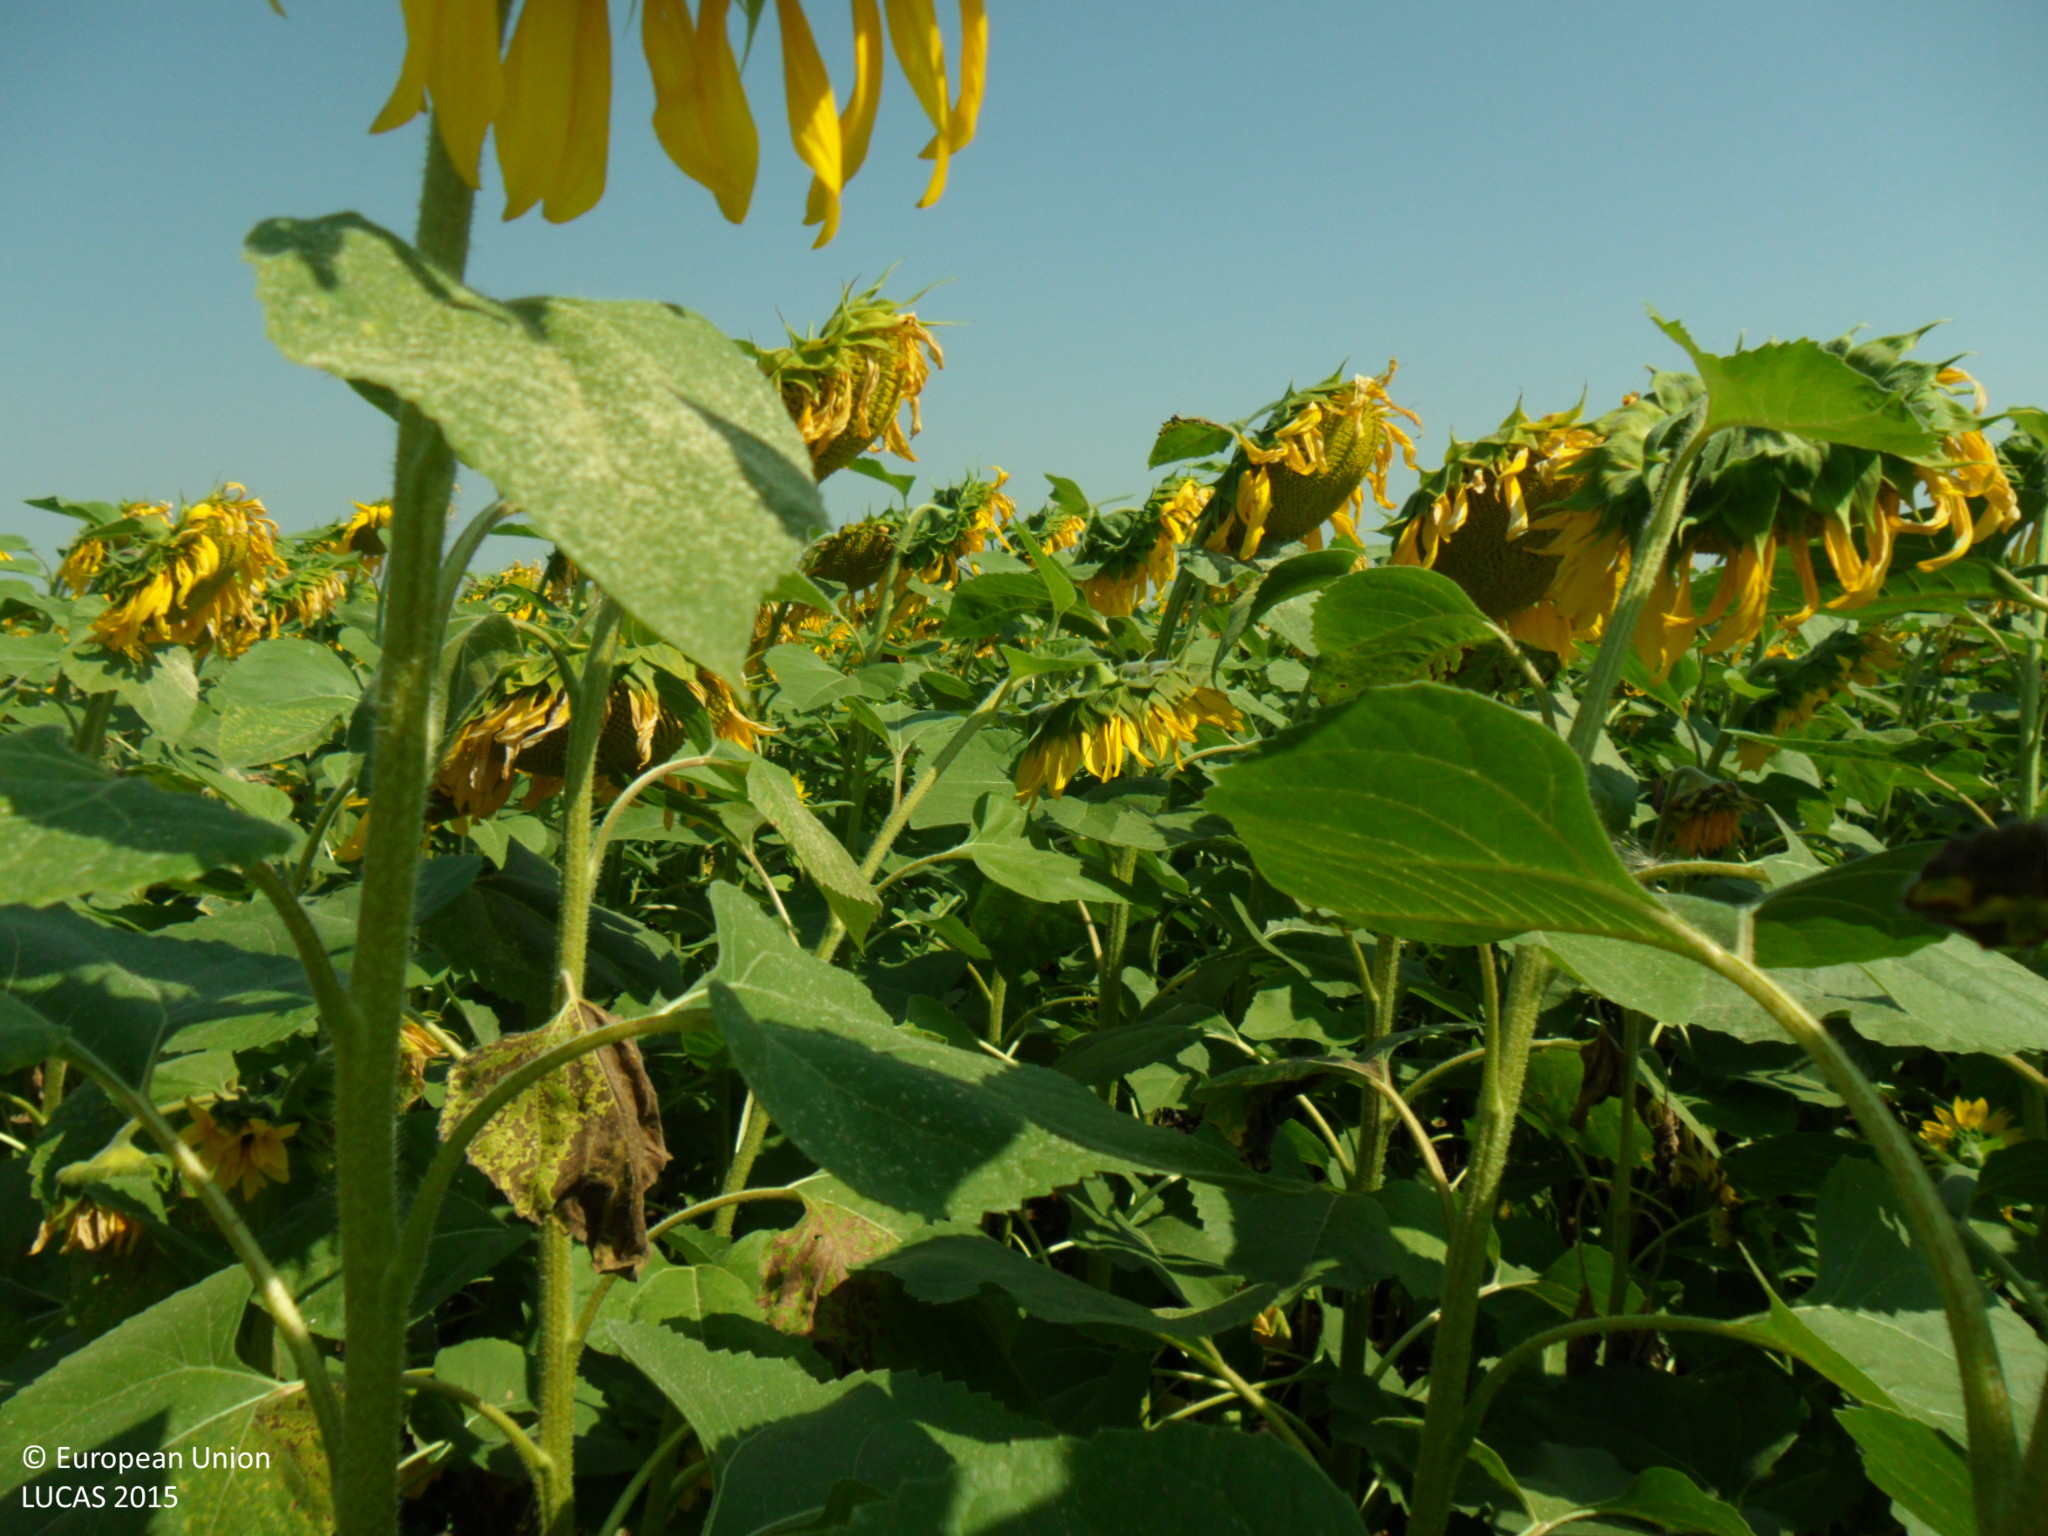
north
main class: Cropland
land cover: Sunflower
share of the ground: > 75 %
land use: Agriculture (excluding fallow land and kitchen gardens)
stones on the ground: < 10 %
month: July
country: BG
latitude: 43.8648
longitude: 26.4957
